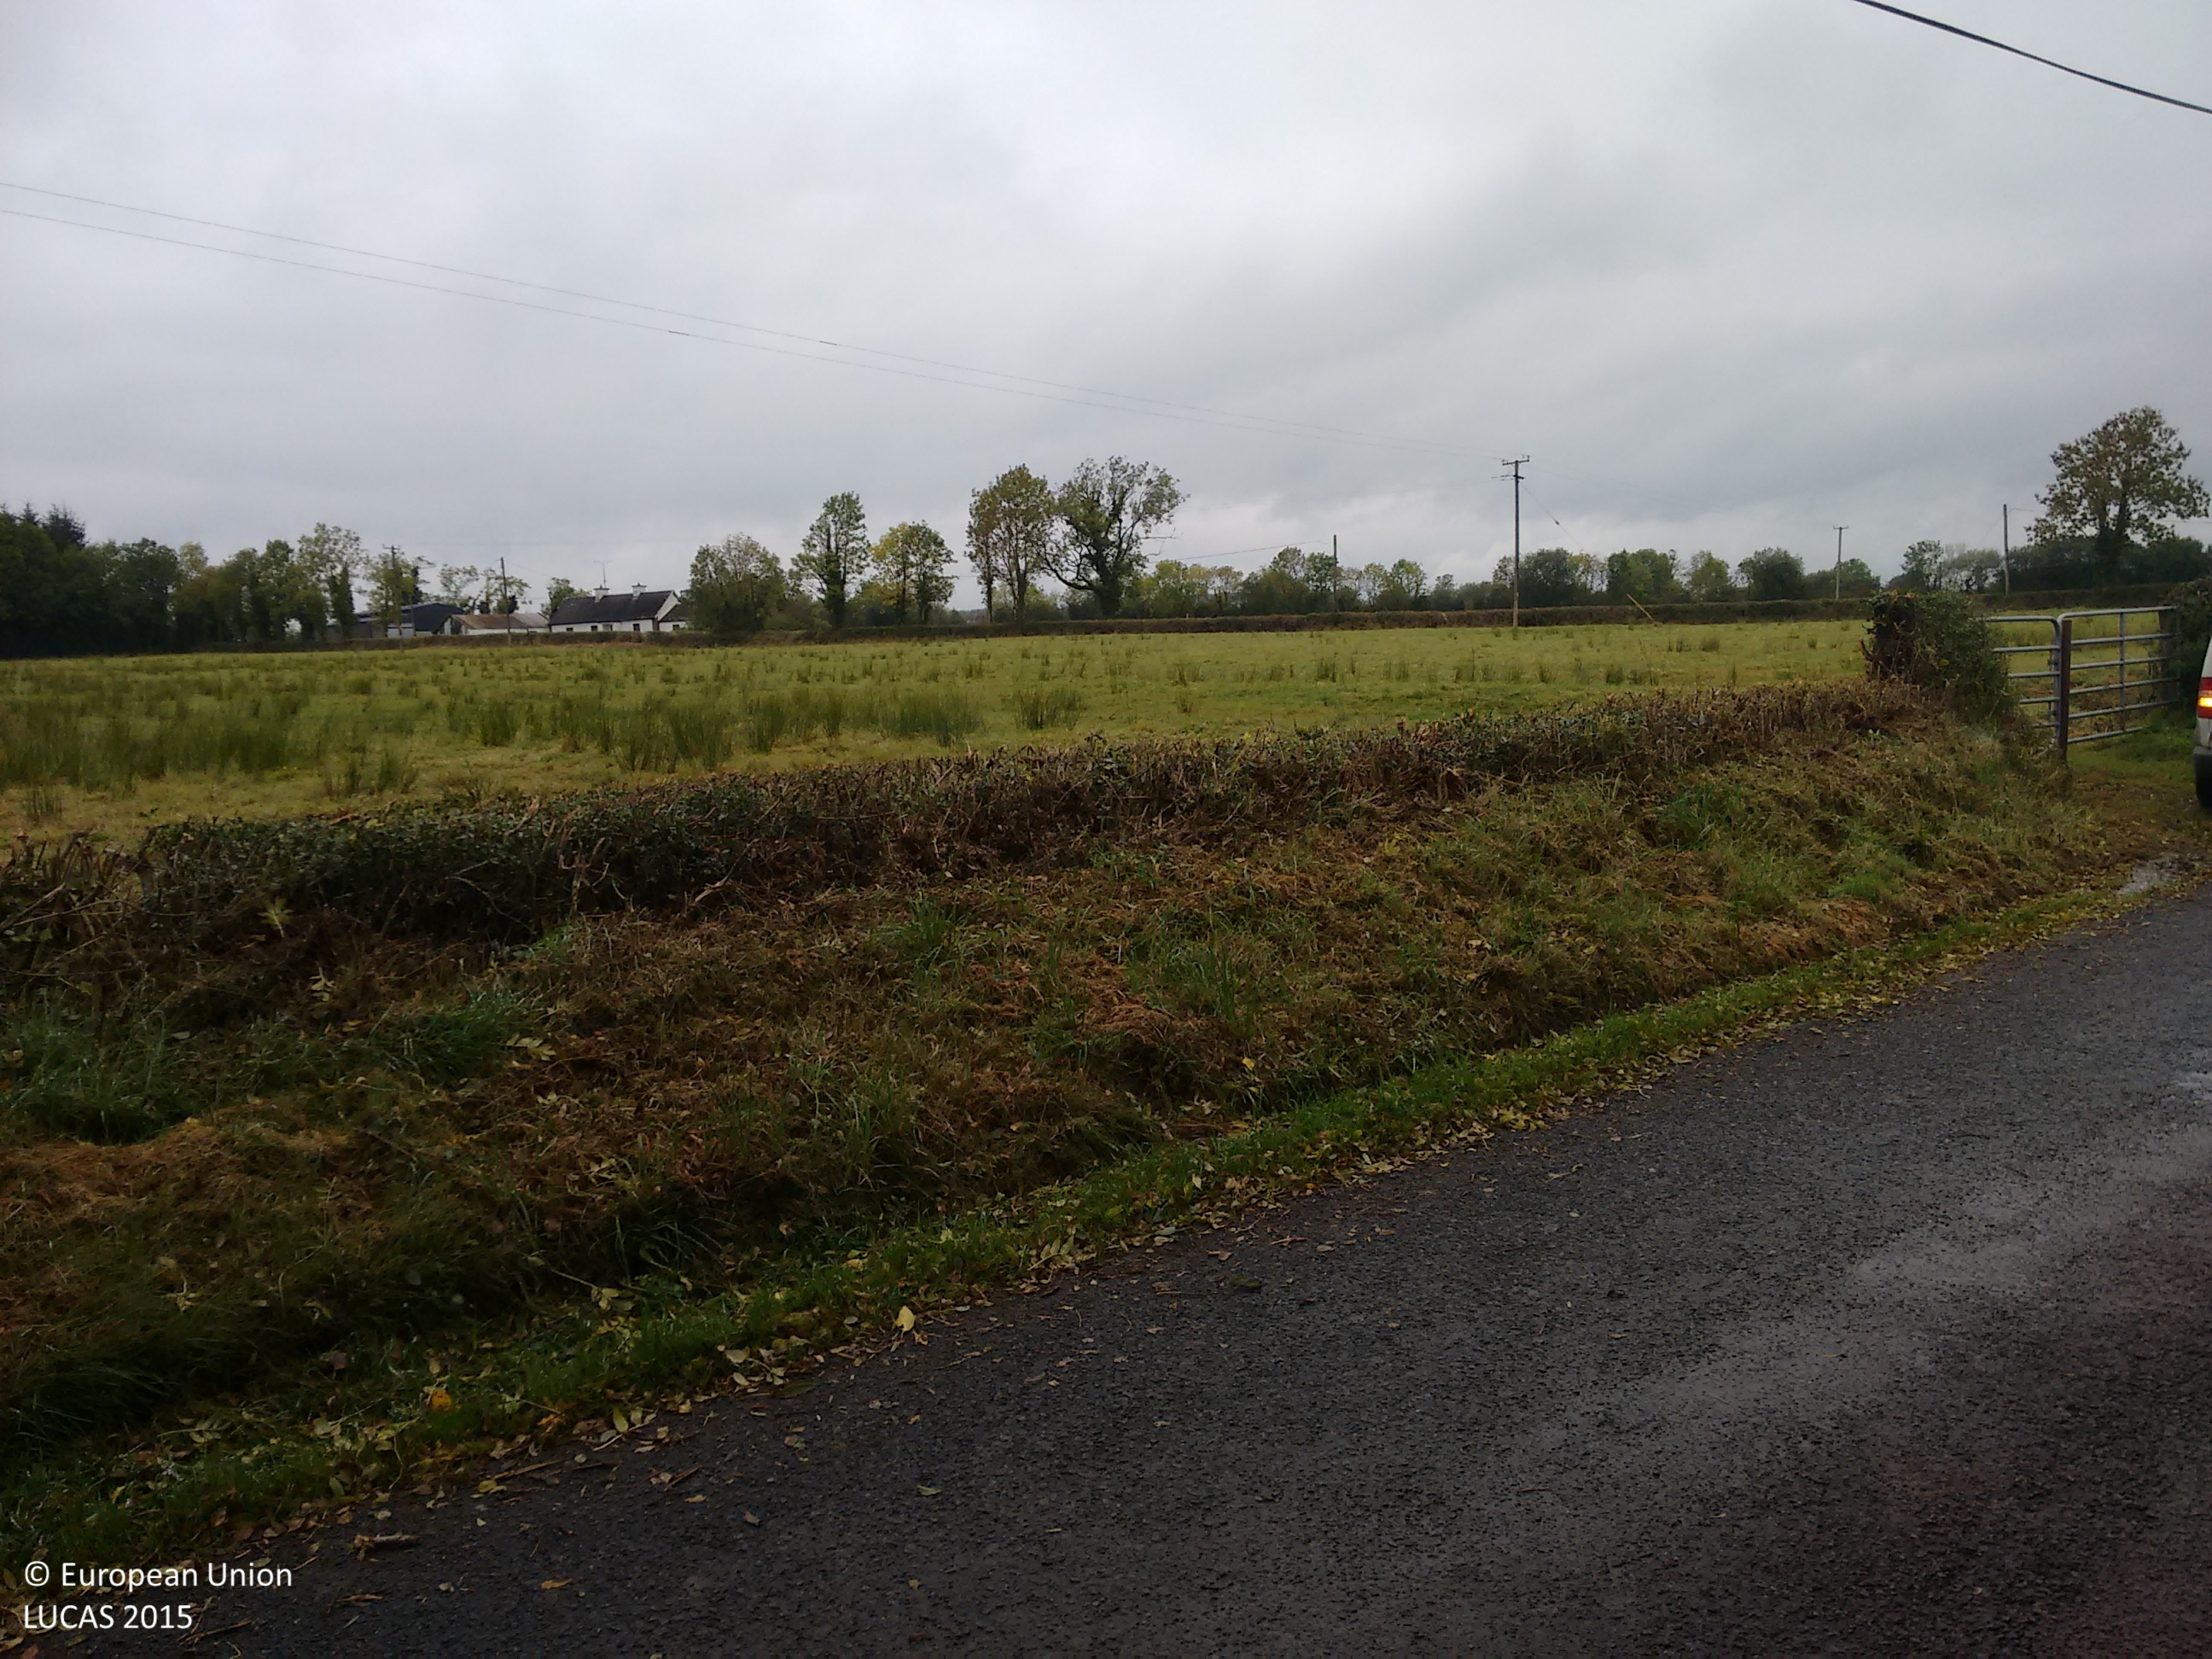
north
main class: Grassland
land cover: Grassland without tree/shrub cover
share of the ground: > 75 %
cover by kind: herbaceous plants 100 %
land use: Agriculture (excluding fallow land and kitchen gardens)
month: October
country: IE
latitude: 53.7927
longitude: -7.9804
